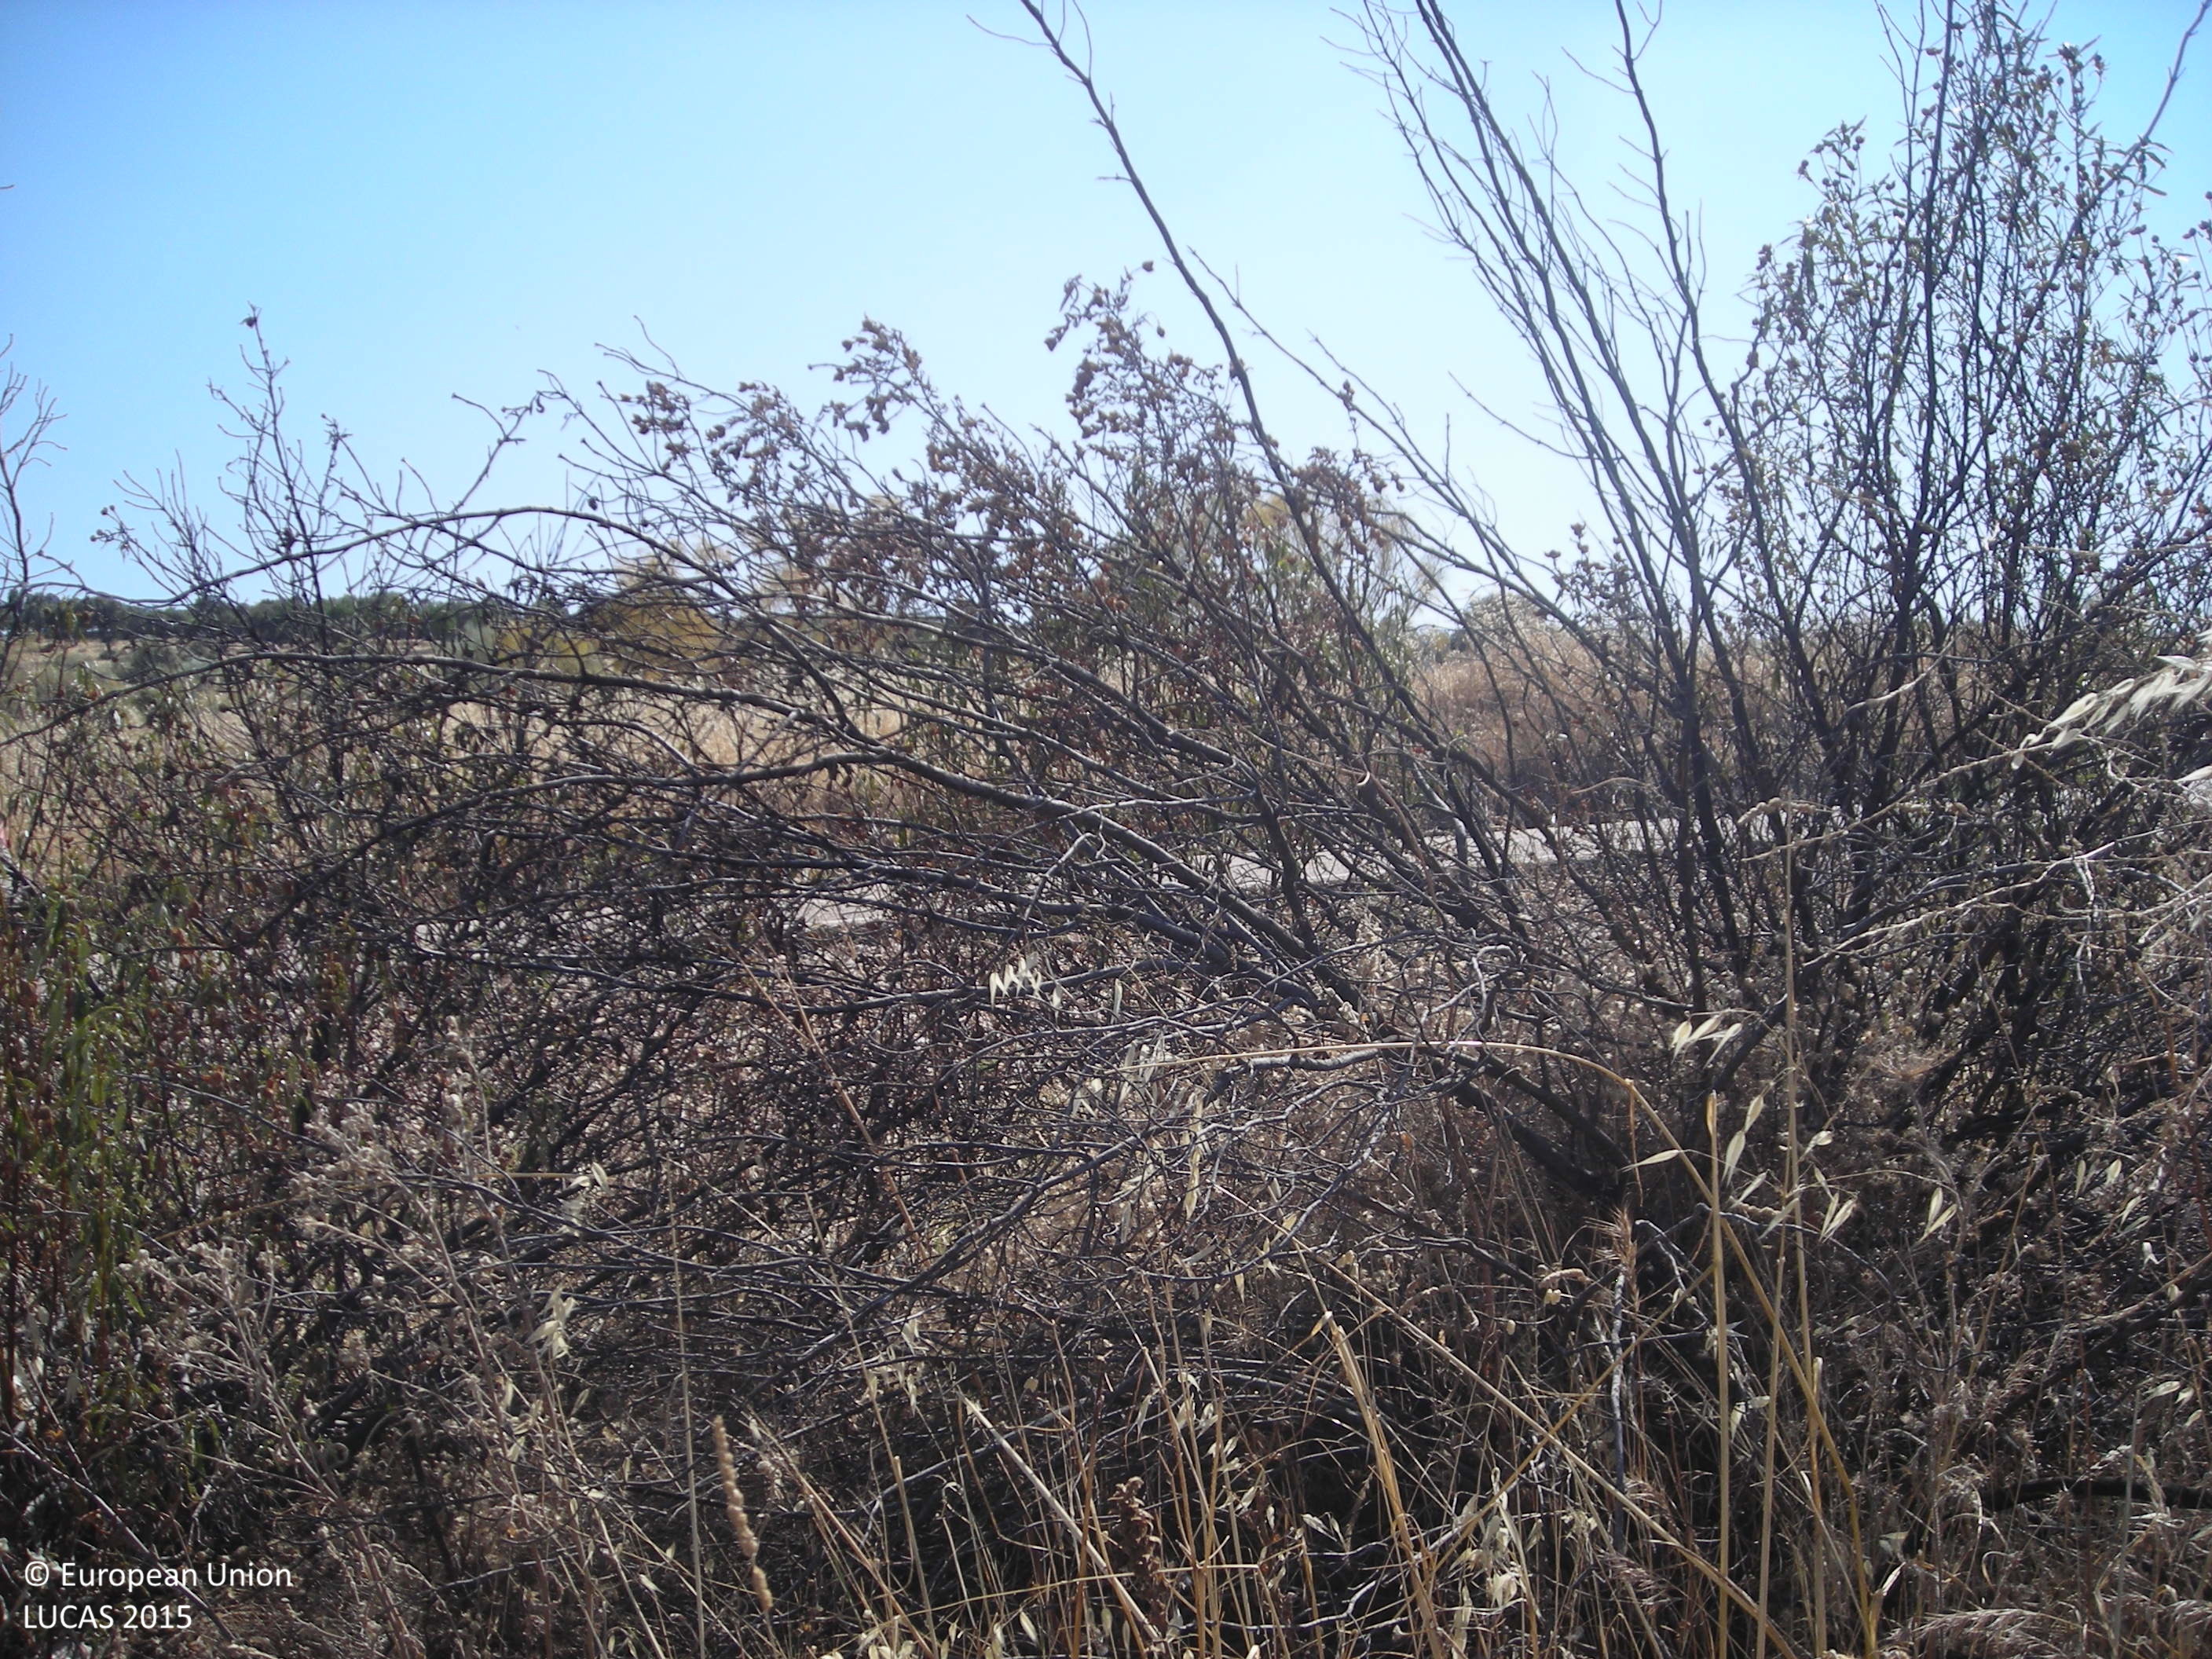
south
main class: Shrubland
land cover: Shrubland without tree cover
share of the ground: > 75 %
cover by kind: shrubs 100 %
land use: Semi-natural and natural areas not in use
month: July
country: ES
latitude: 38.6930
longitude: -5.8533
